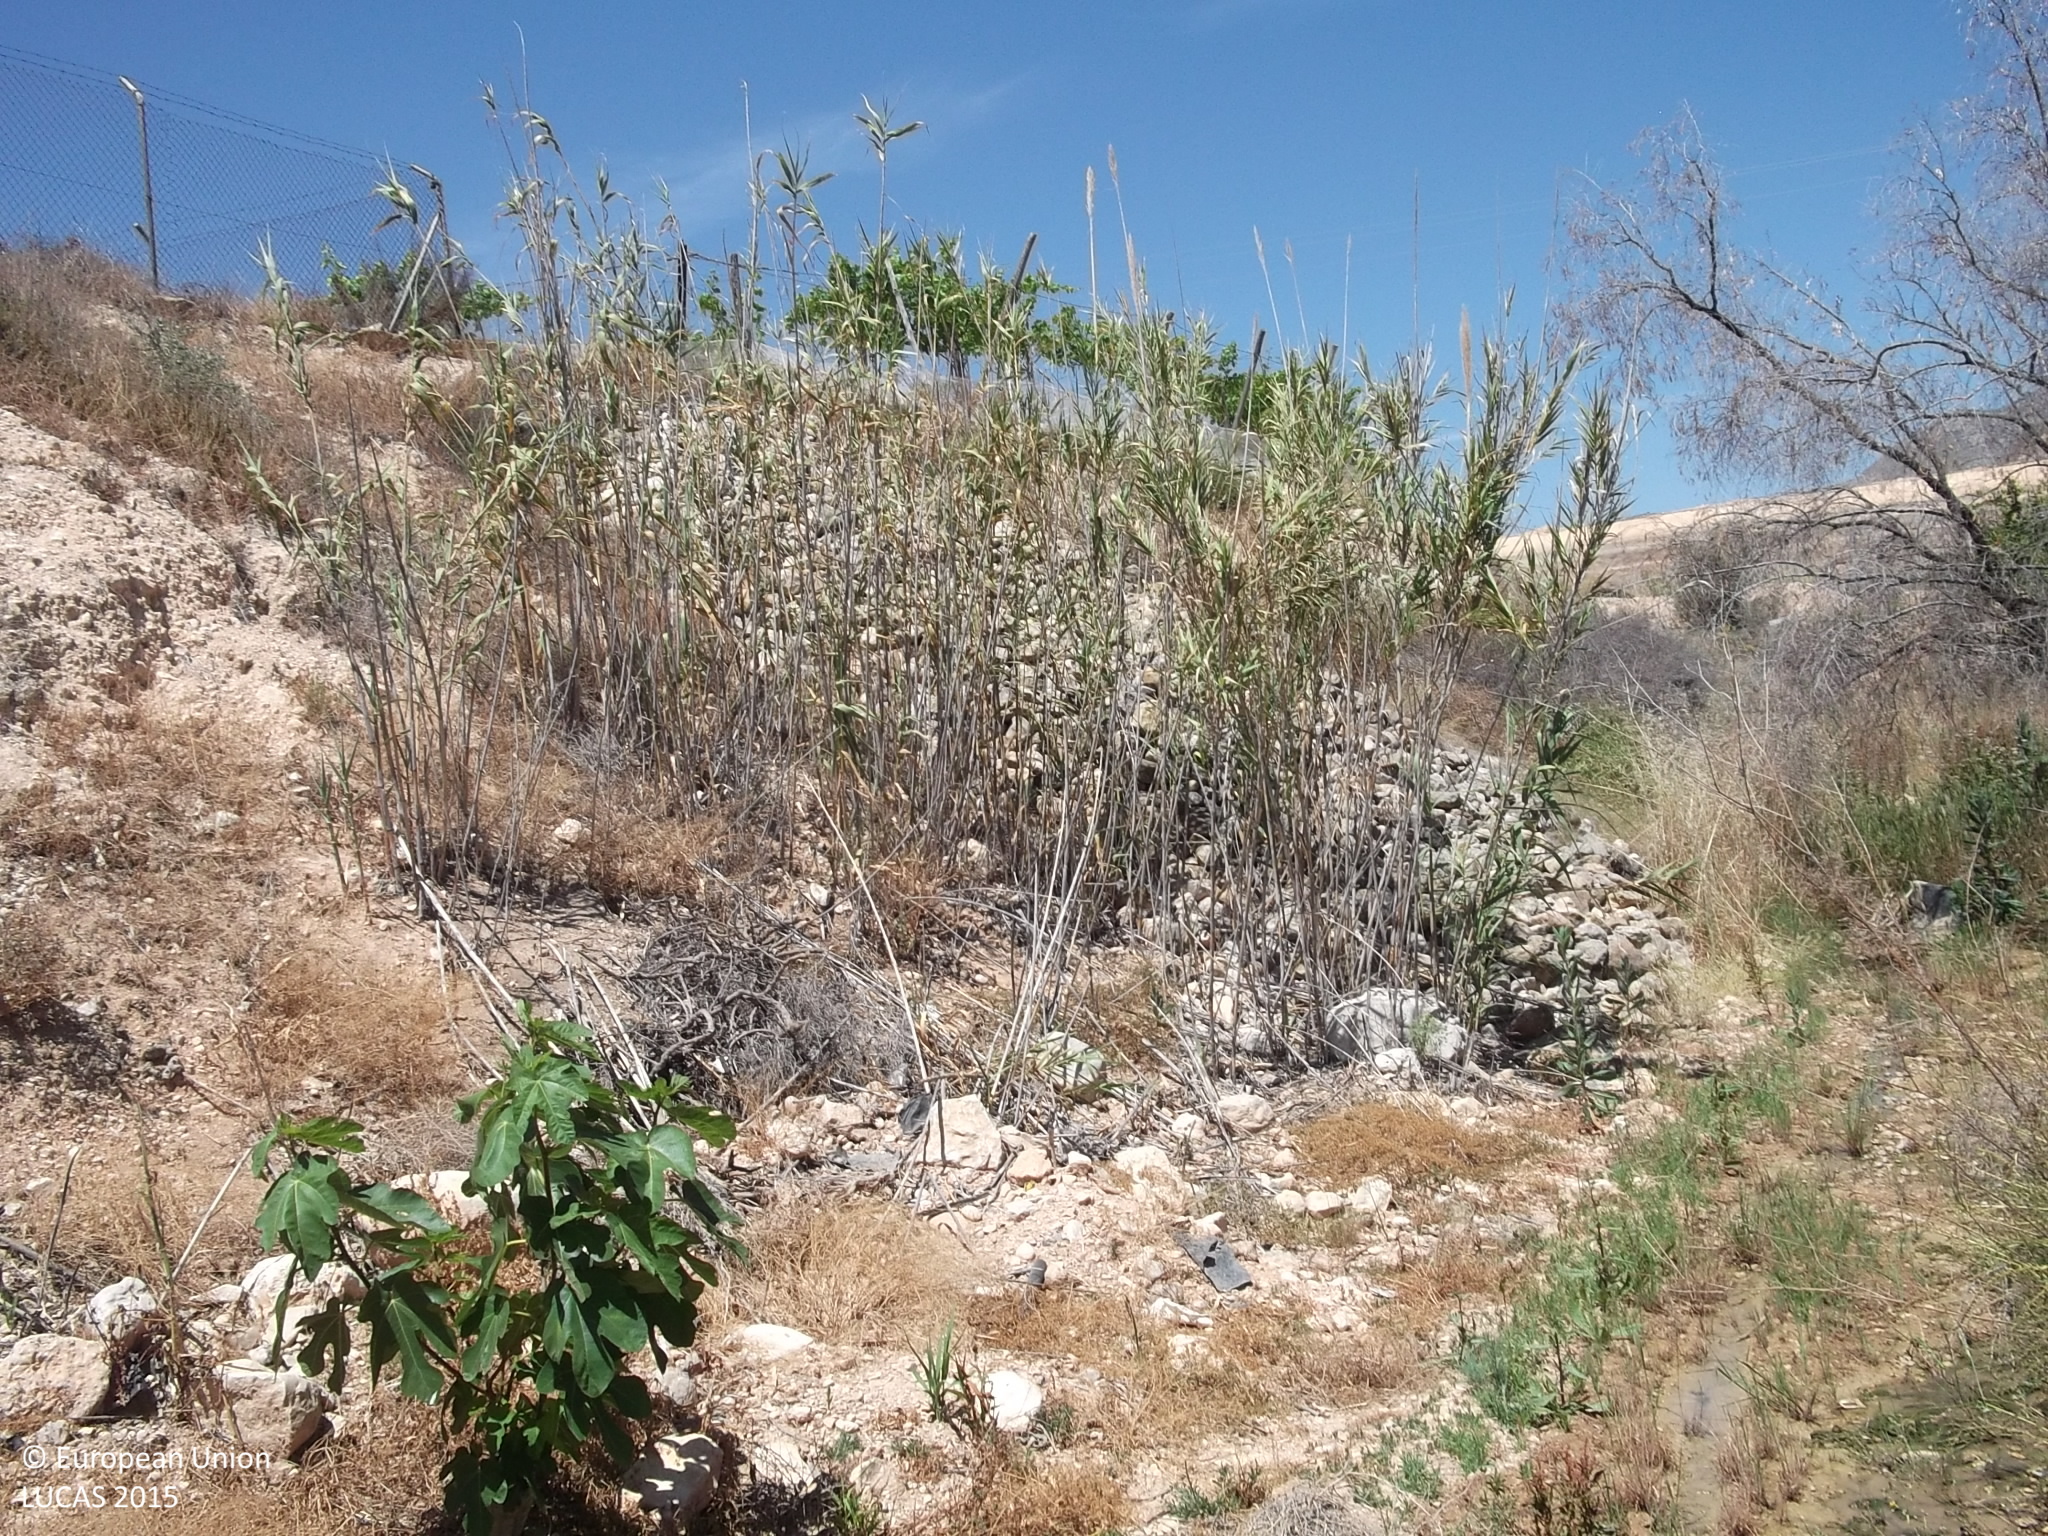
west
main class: Shrubland
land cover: Shrubland without tree cover
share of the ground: 10 - 25 %
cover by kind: herbaceous plants 50 %, consolidated bare surface 30 %, shrubs 20 %
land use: Abandoned areas
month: May
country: ES
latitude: 38.2192
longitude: -0.8708
